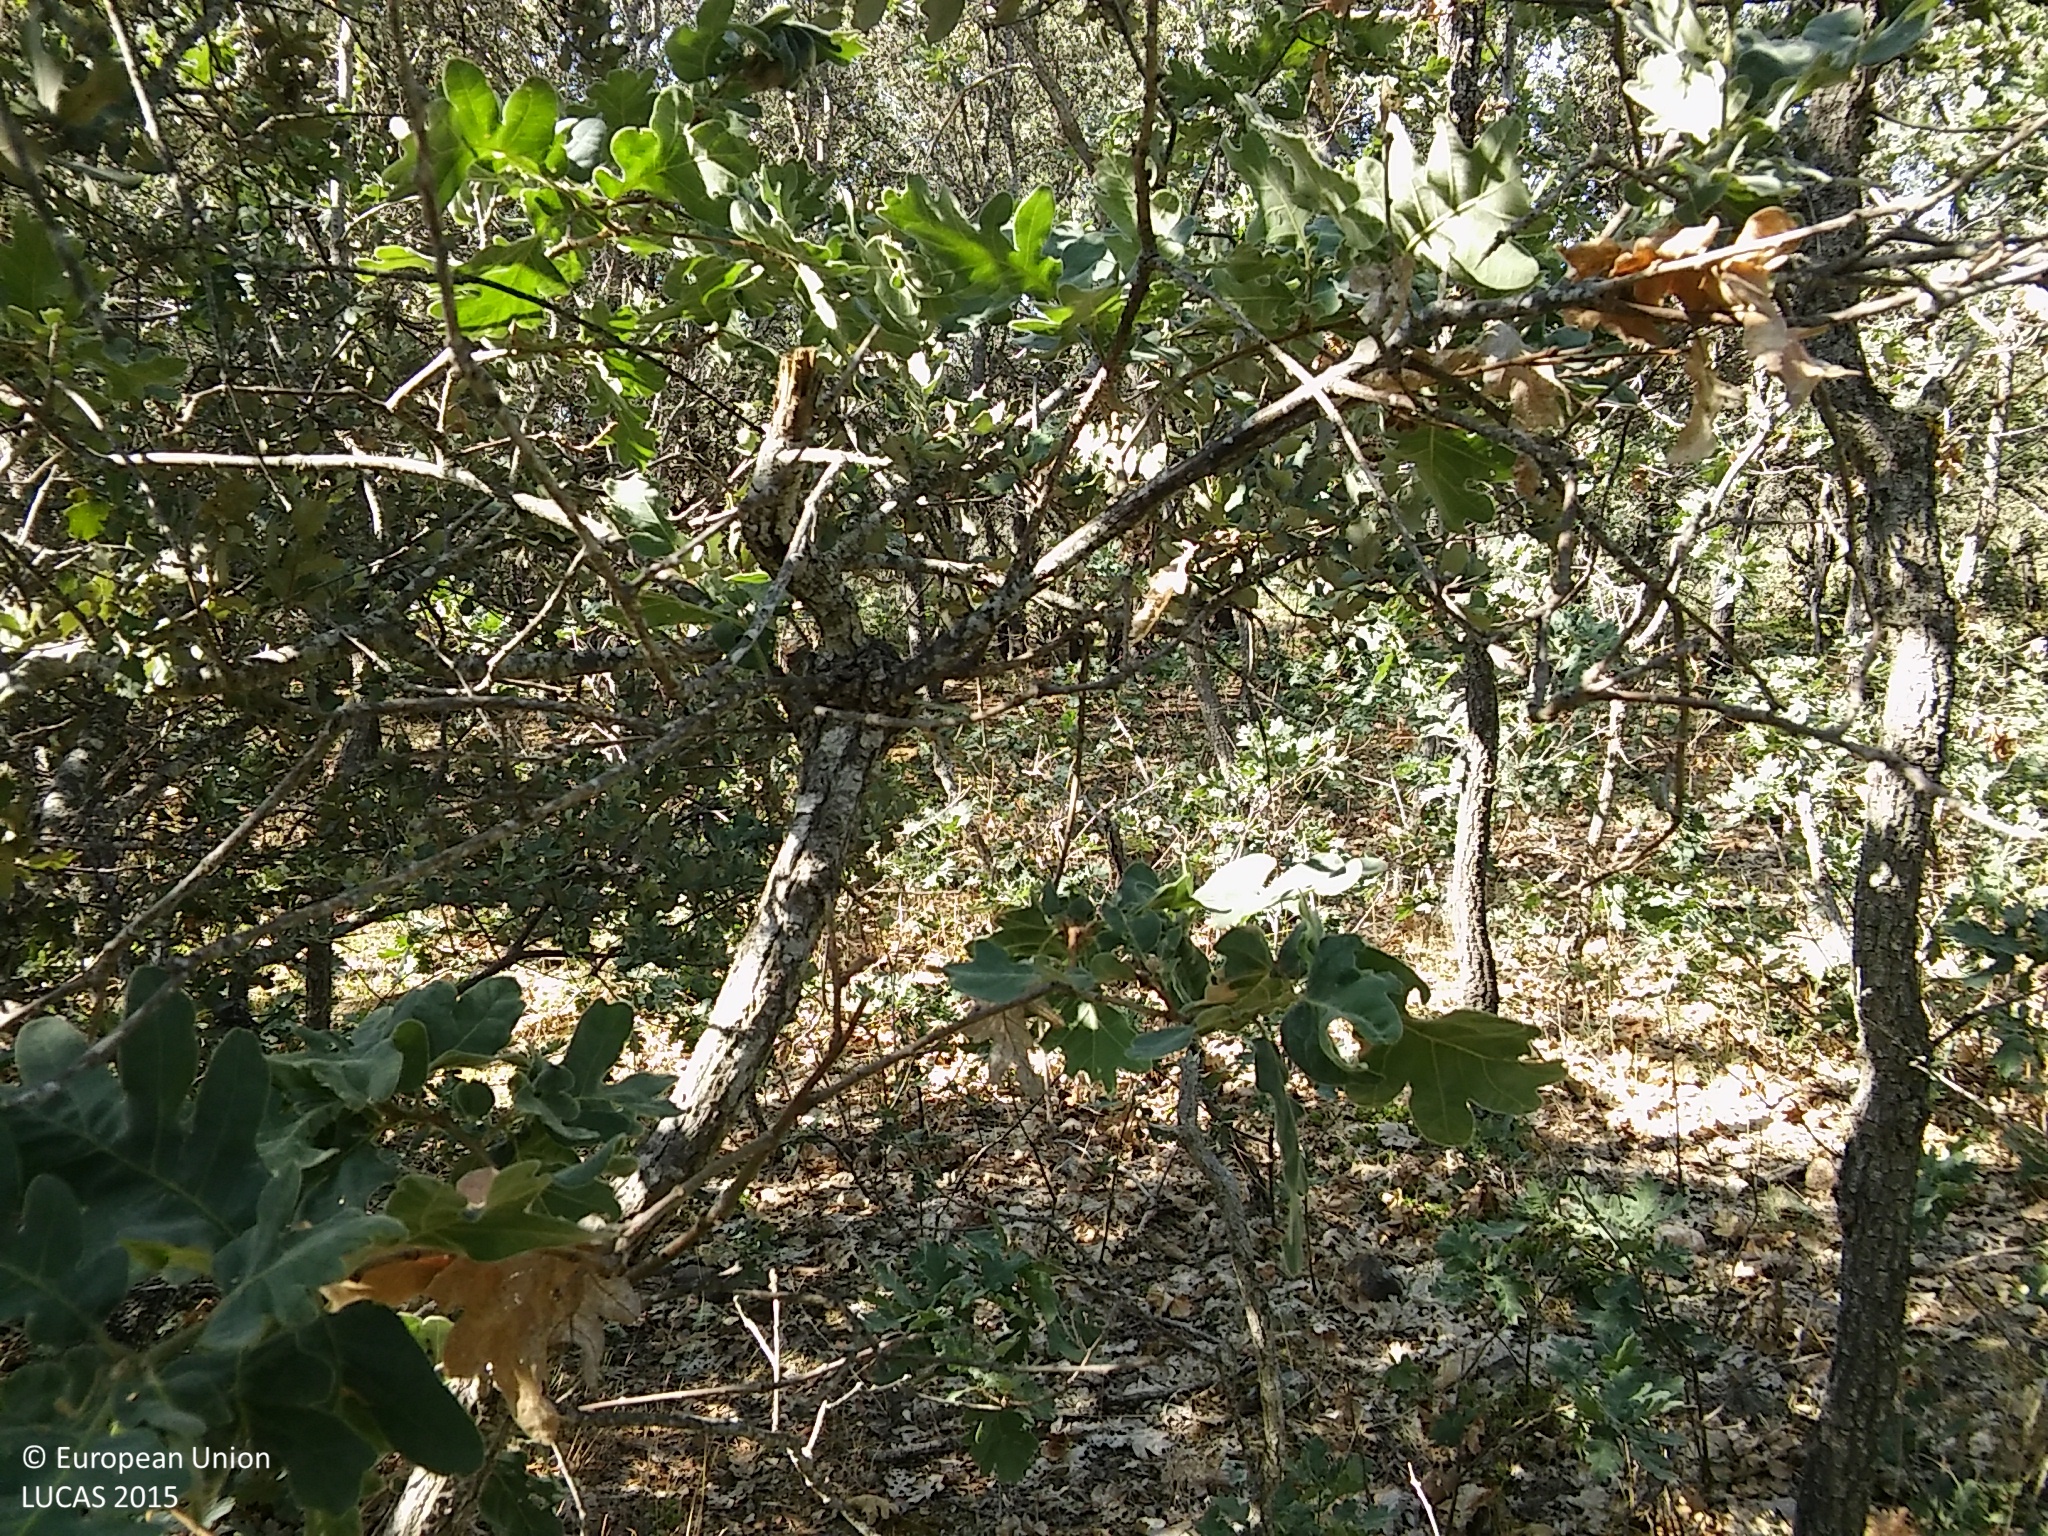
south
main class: Woodland
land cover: Broadleaved woodland
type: thermophilous deciduous forest
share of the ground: 50 - 75 %
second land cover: Shrubland without tree cover
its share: 25 - 50 %
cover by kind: broadleaved forest trees 50 %, shrubs 30 %, herbaceous plants 10 %, lichens and mosses 10 %
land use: Forestry
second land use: Agriculture (excluding fallow land and kitchen gardens)
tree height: > 5 m
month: July
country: ES
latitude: 41.3444
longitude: -3.4909
